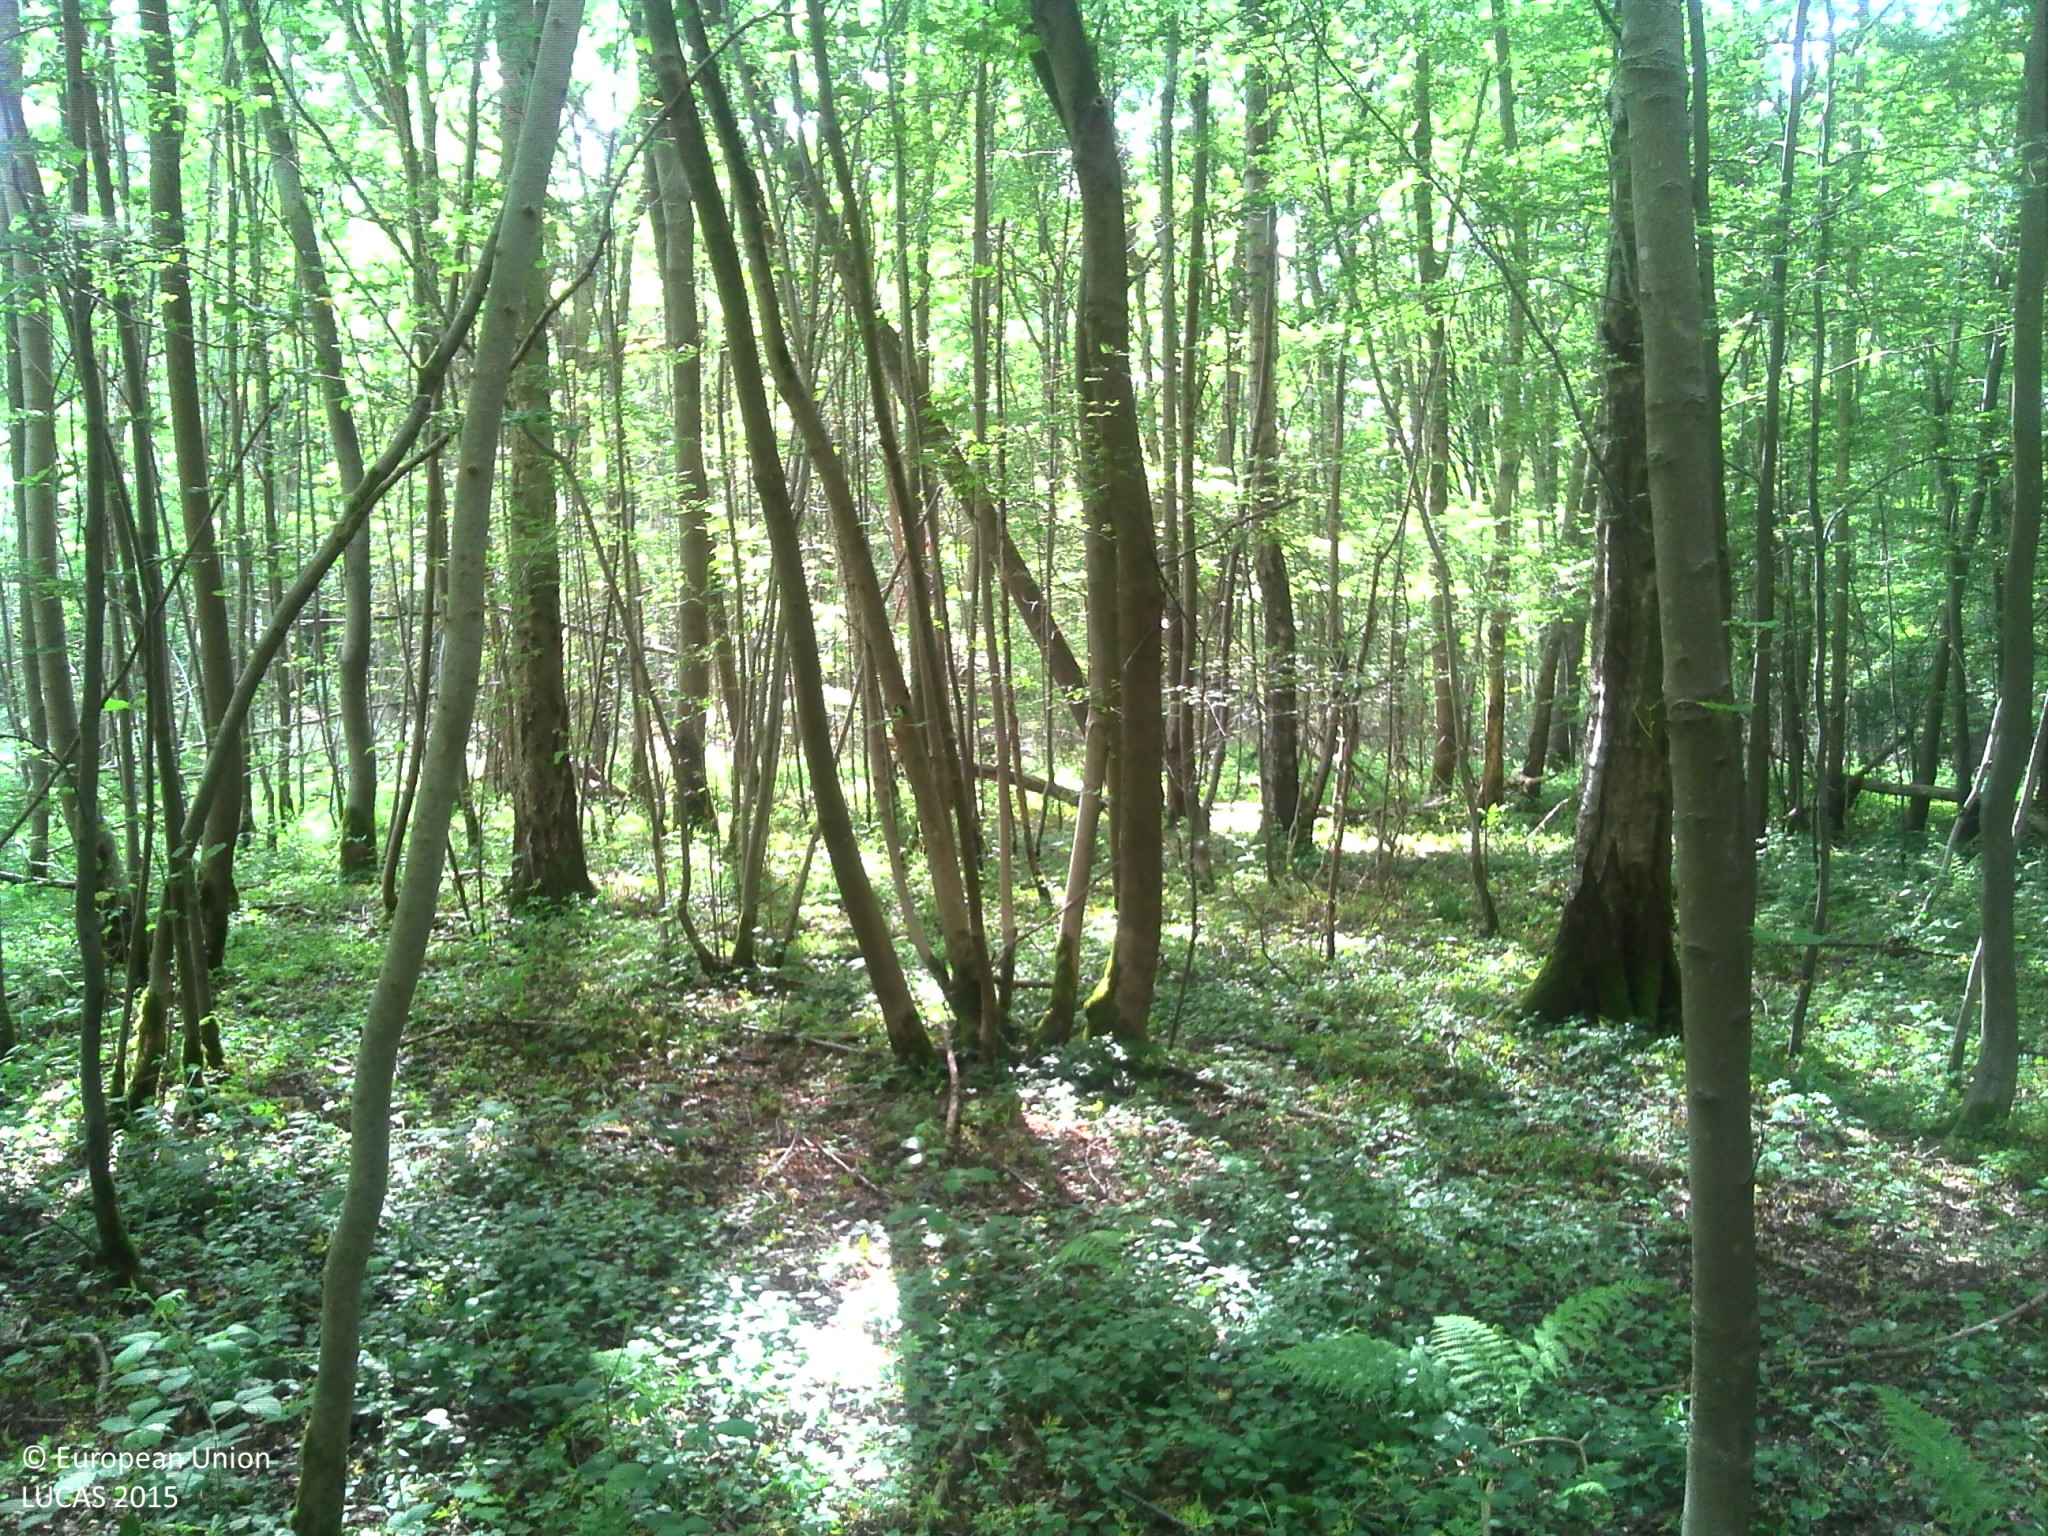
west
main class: Woodland
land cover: Broadleaved woodland
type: mesophytic deciduous forest
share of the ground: > 75 %
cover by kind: broadleaved forest trees 85 %, herbaceous plants 15 %
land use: Forestry
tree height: > 5 m
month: June
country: FR
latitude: 49.6769
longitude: 3.2426
